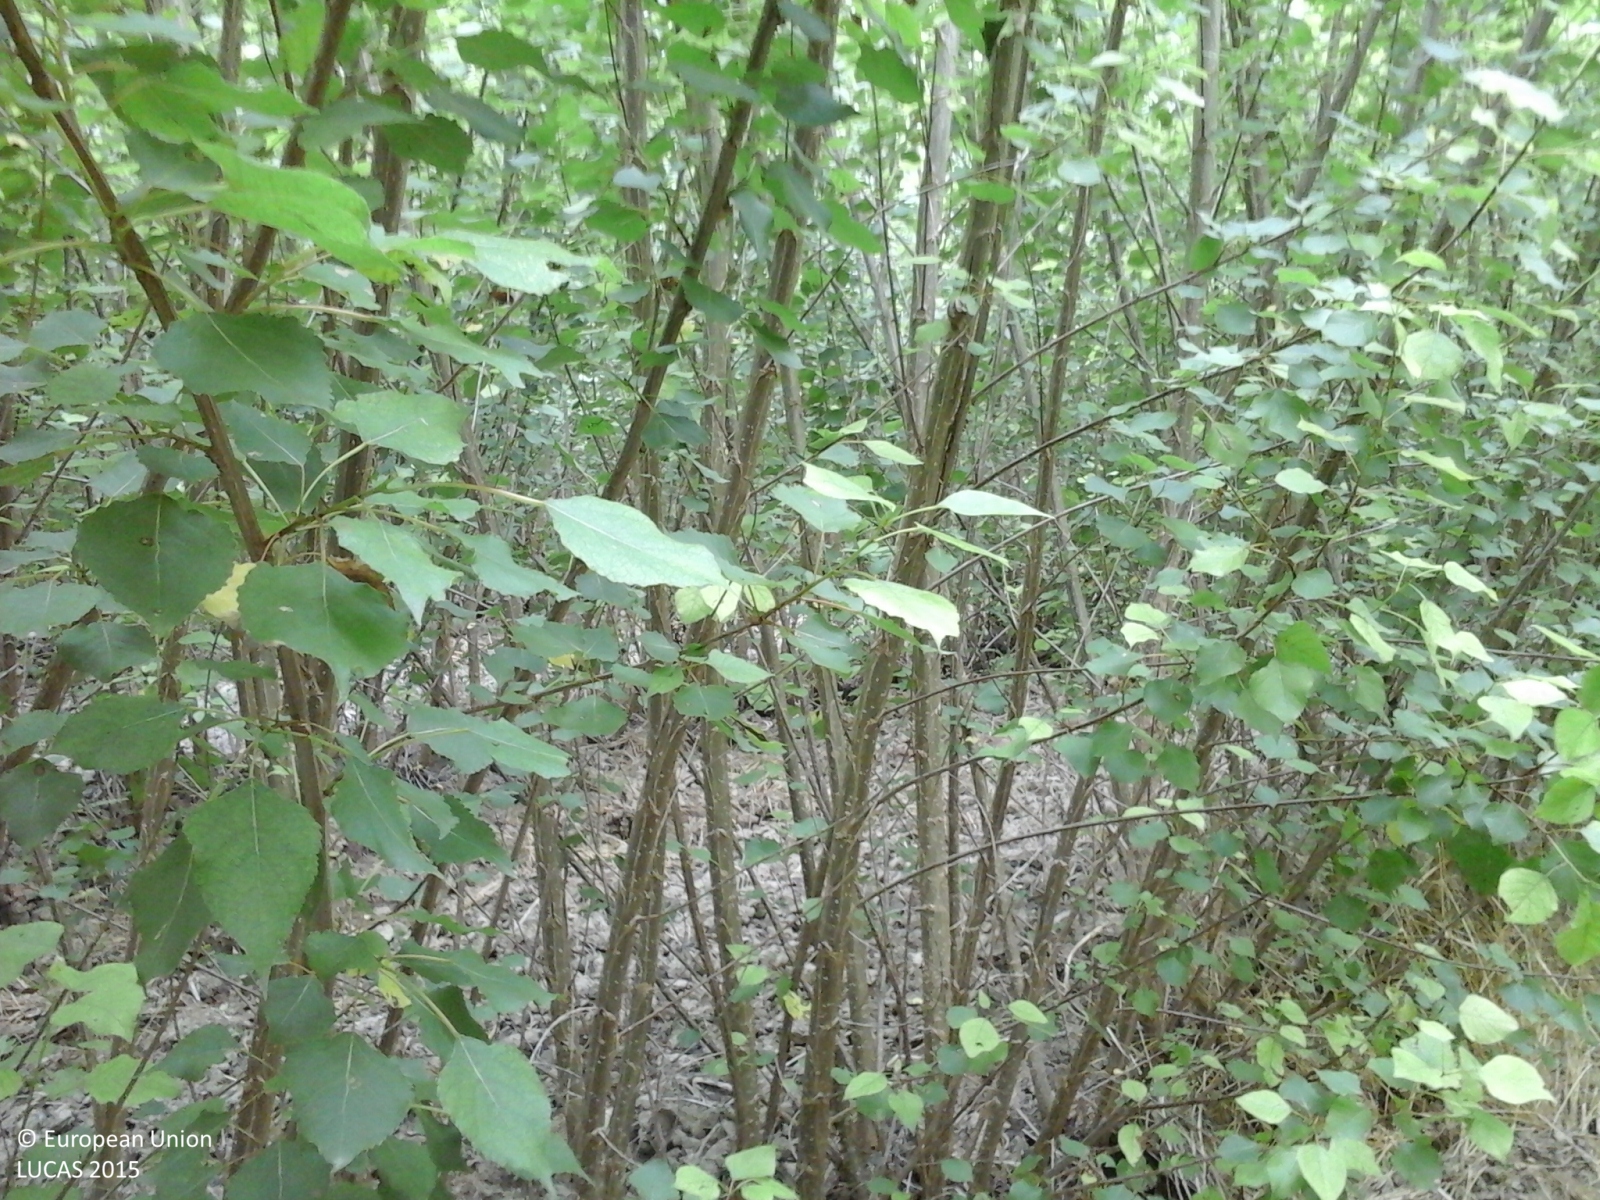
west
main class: Woodland
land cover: Broadleaved woodland
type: non-riverine alder, birch or aspen forest
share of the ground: > 75 %
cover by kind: broadleaved forest trees 100 %
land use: Forestry
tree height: < 5 m
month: June
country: IT
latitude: 44.8021
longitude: 11.9053
